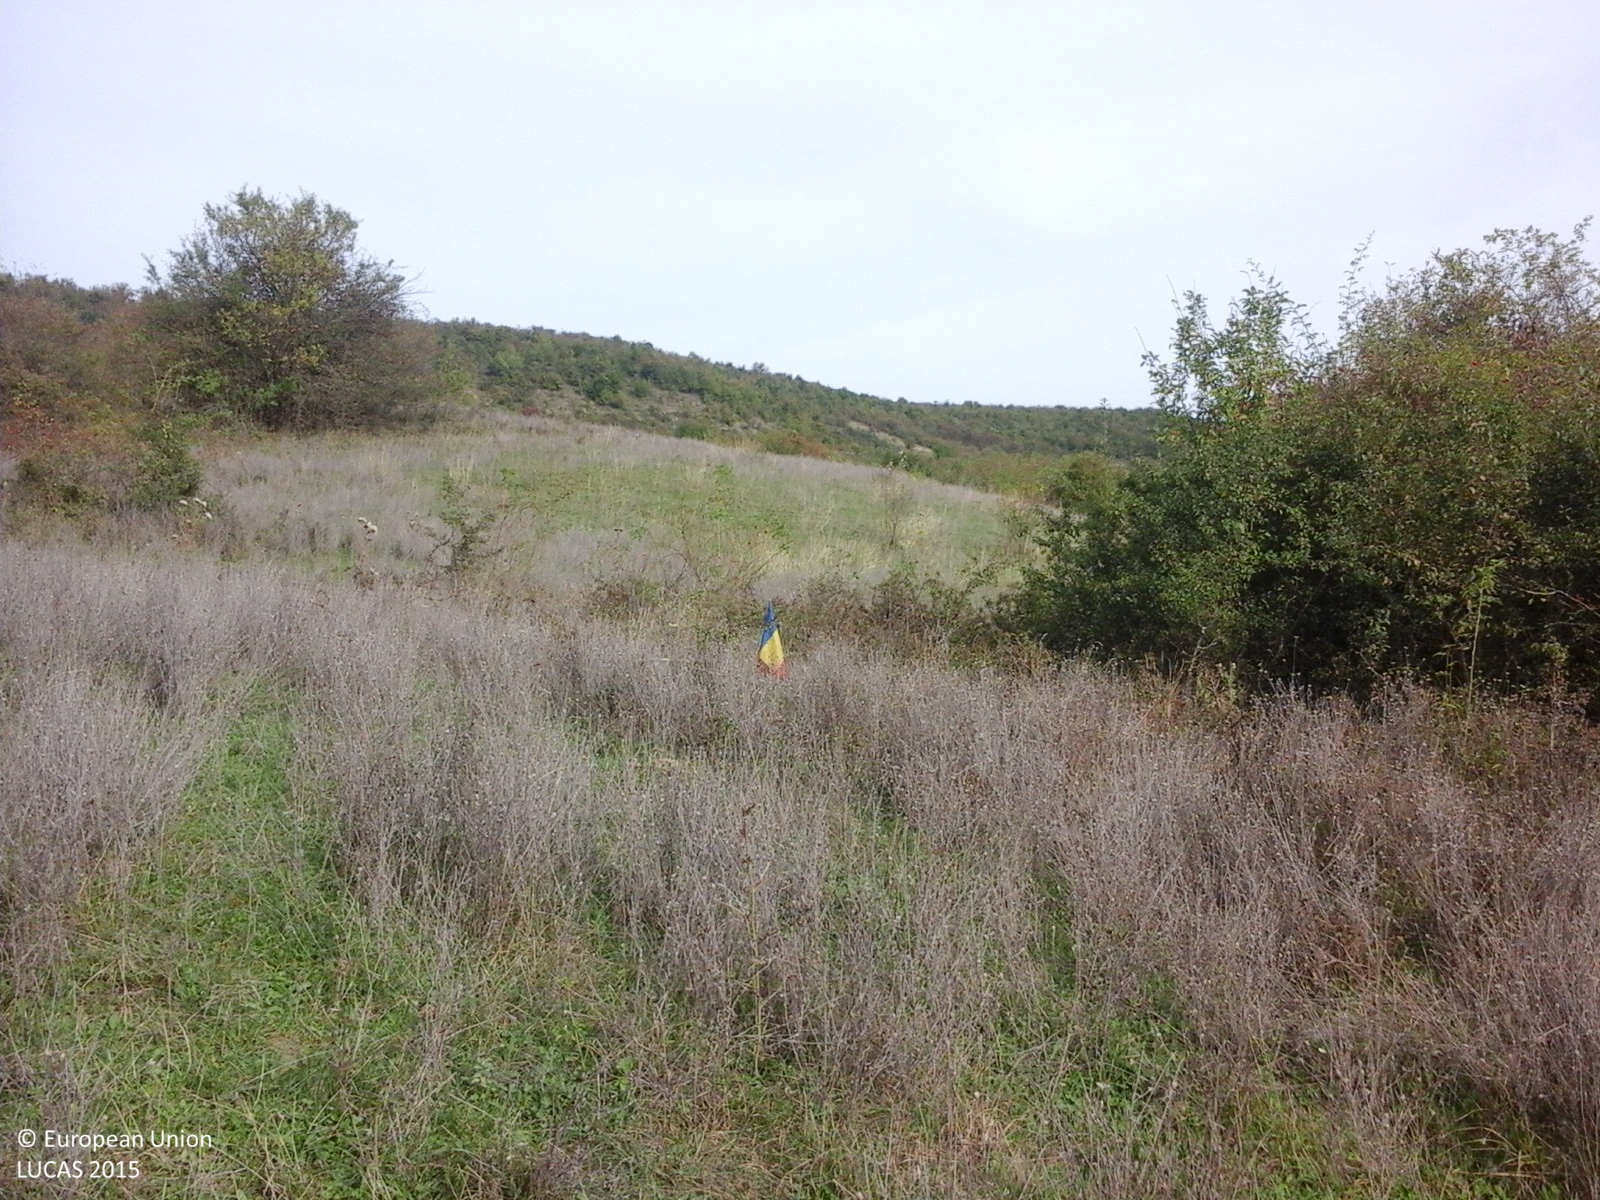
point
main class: Grassland
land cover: Spontaneously vegetated surfaces
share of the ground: > 75 %
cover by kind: herbaceous plants 100 %
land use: Fallow land
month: September
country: RO
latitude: 47.1287
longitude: 23.9617
